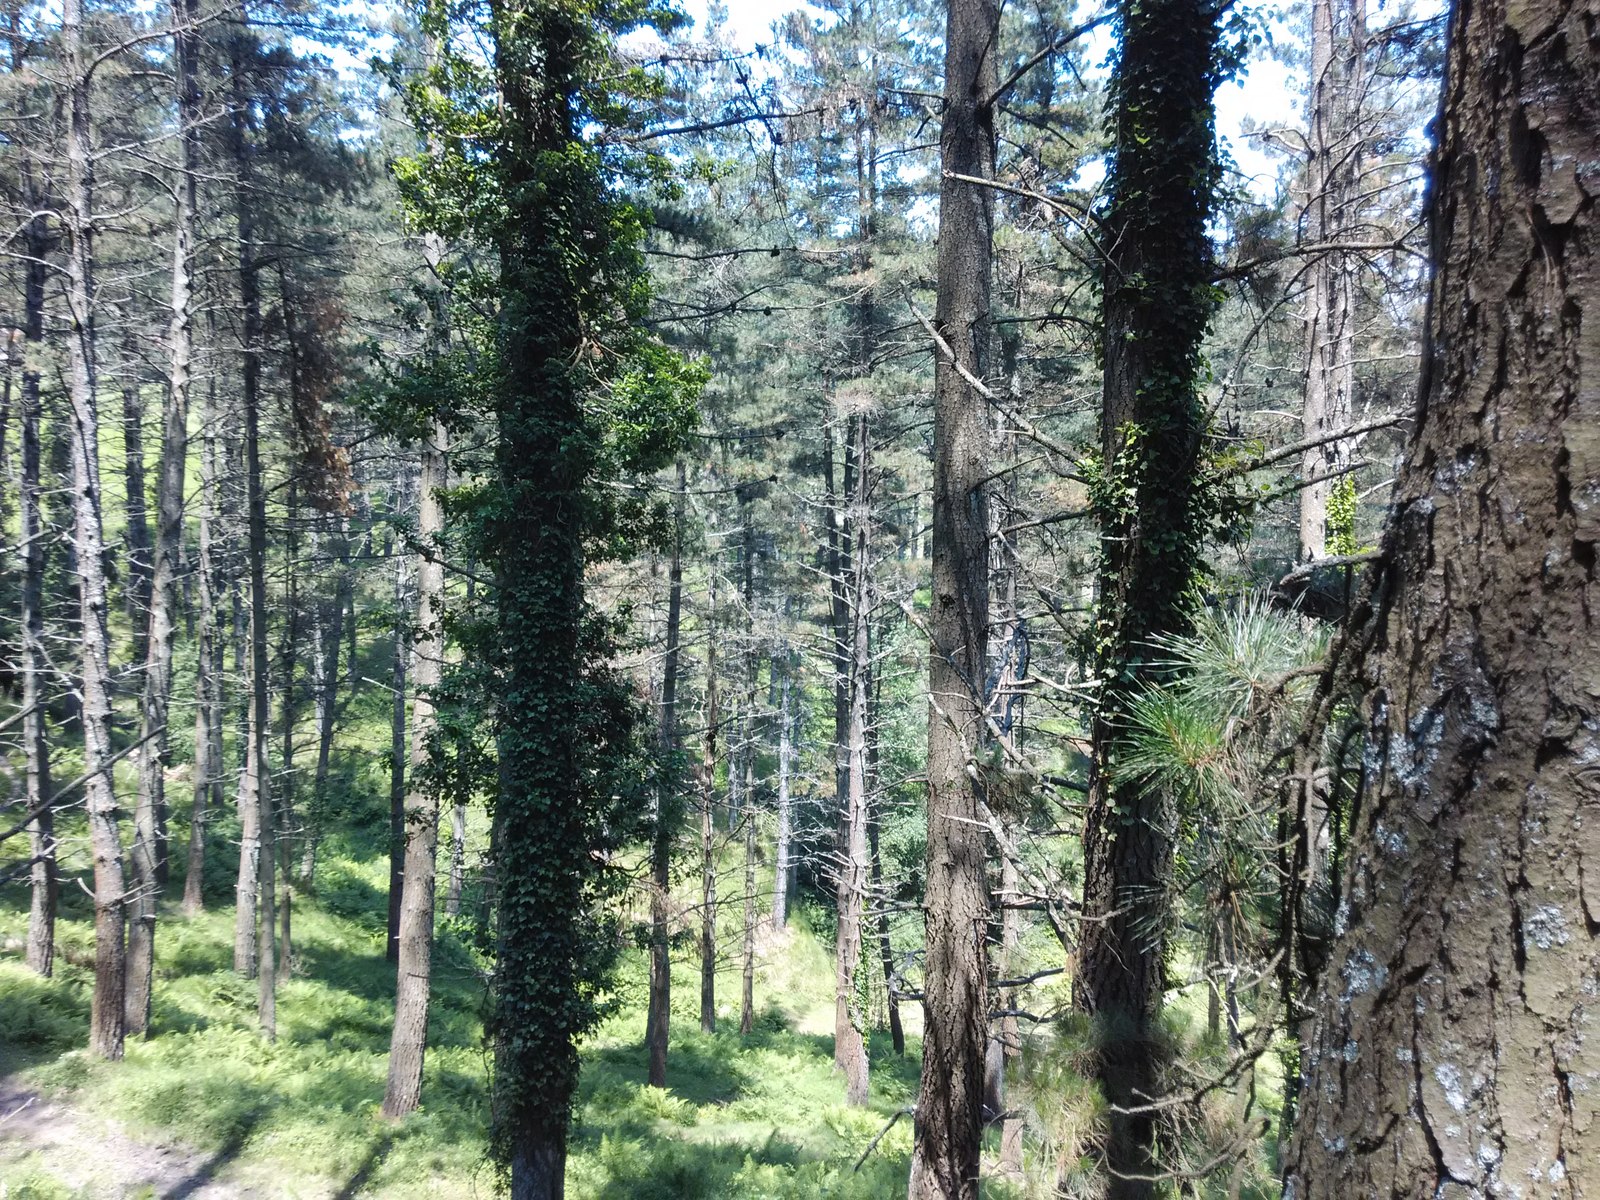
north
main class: Woodland
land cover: Pine dominated coniferous woodland
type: exotic forest
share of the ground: > 75 %
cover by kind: coniferous forest trees 100 %
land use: Forestry
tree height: > 5 m
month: June
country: ES
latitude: 43.2354
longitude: -2.5769
